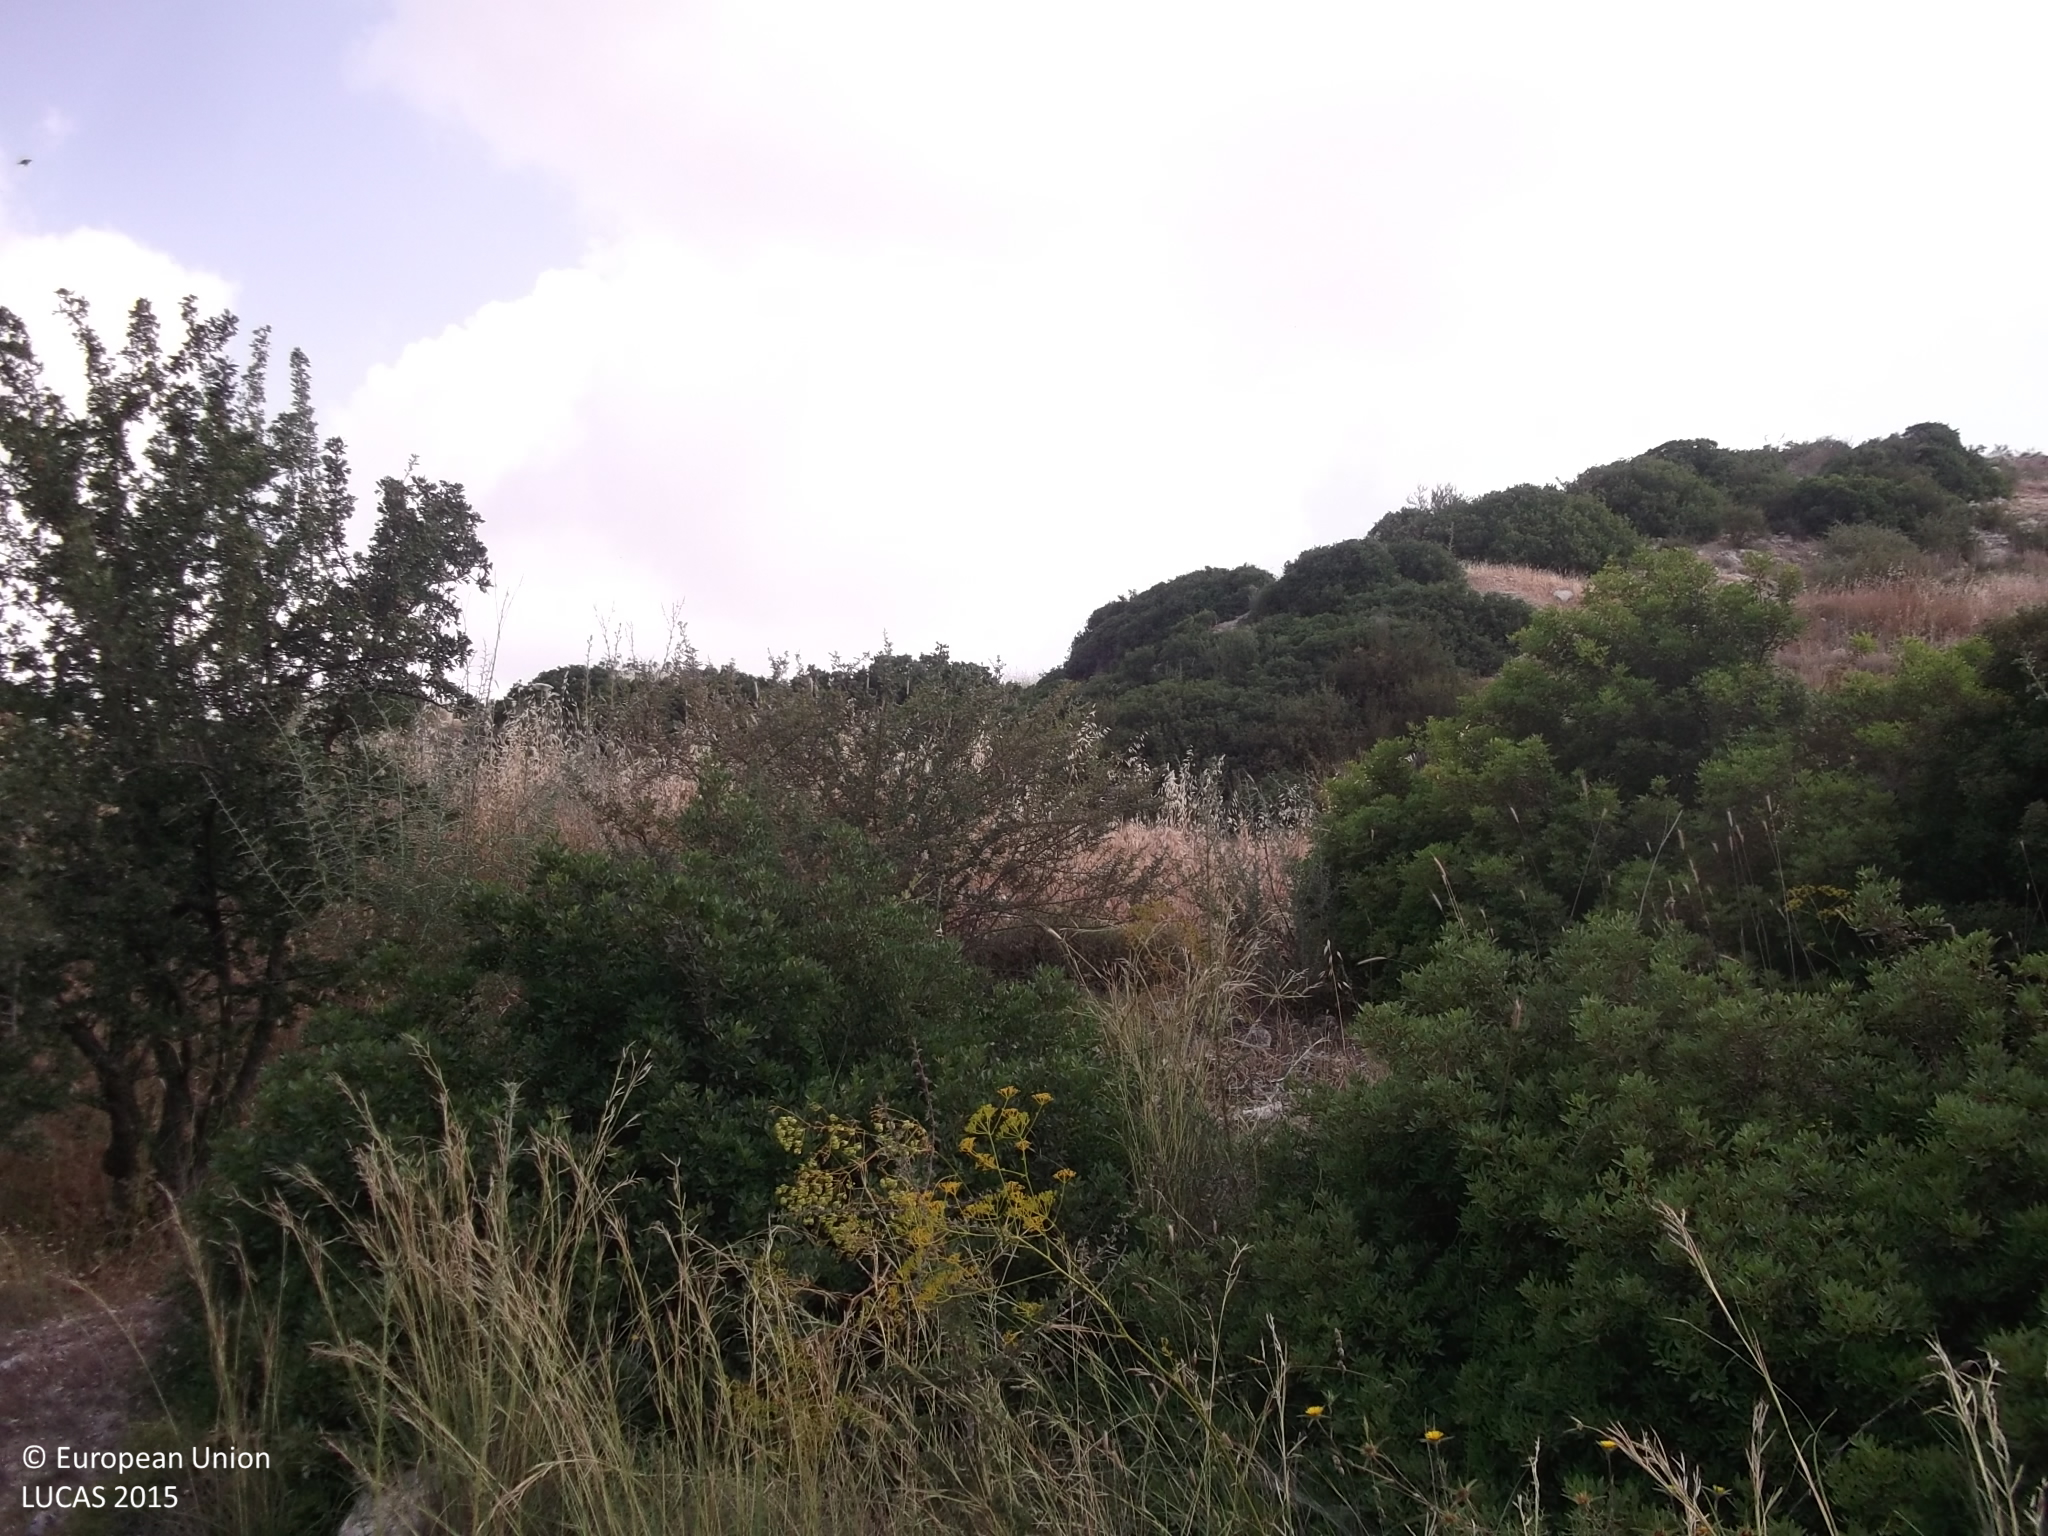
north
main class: Shrubland
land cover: Shrubland without tree cover
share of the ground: 25 - 50 %
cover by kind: herbaceous plants 55 %, shrubs 35 %, unconsolidated bare surface 10 %
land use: Semi-natural and natural areas not in use
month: May
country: CY
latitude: 34.9950
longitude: 32.4257
